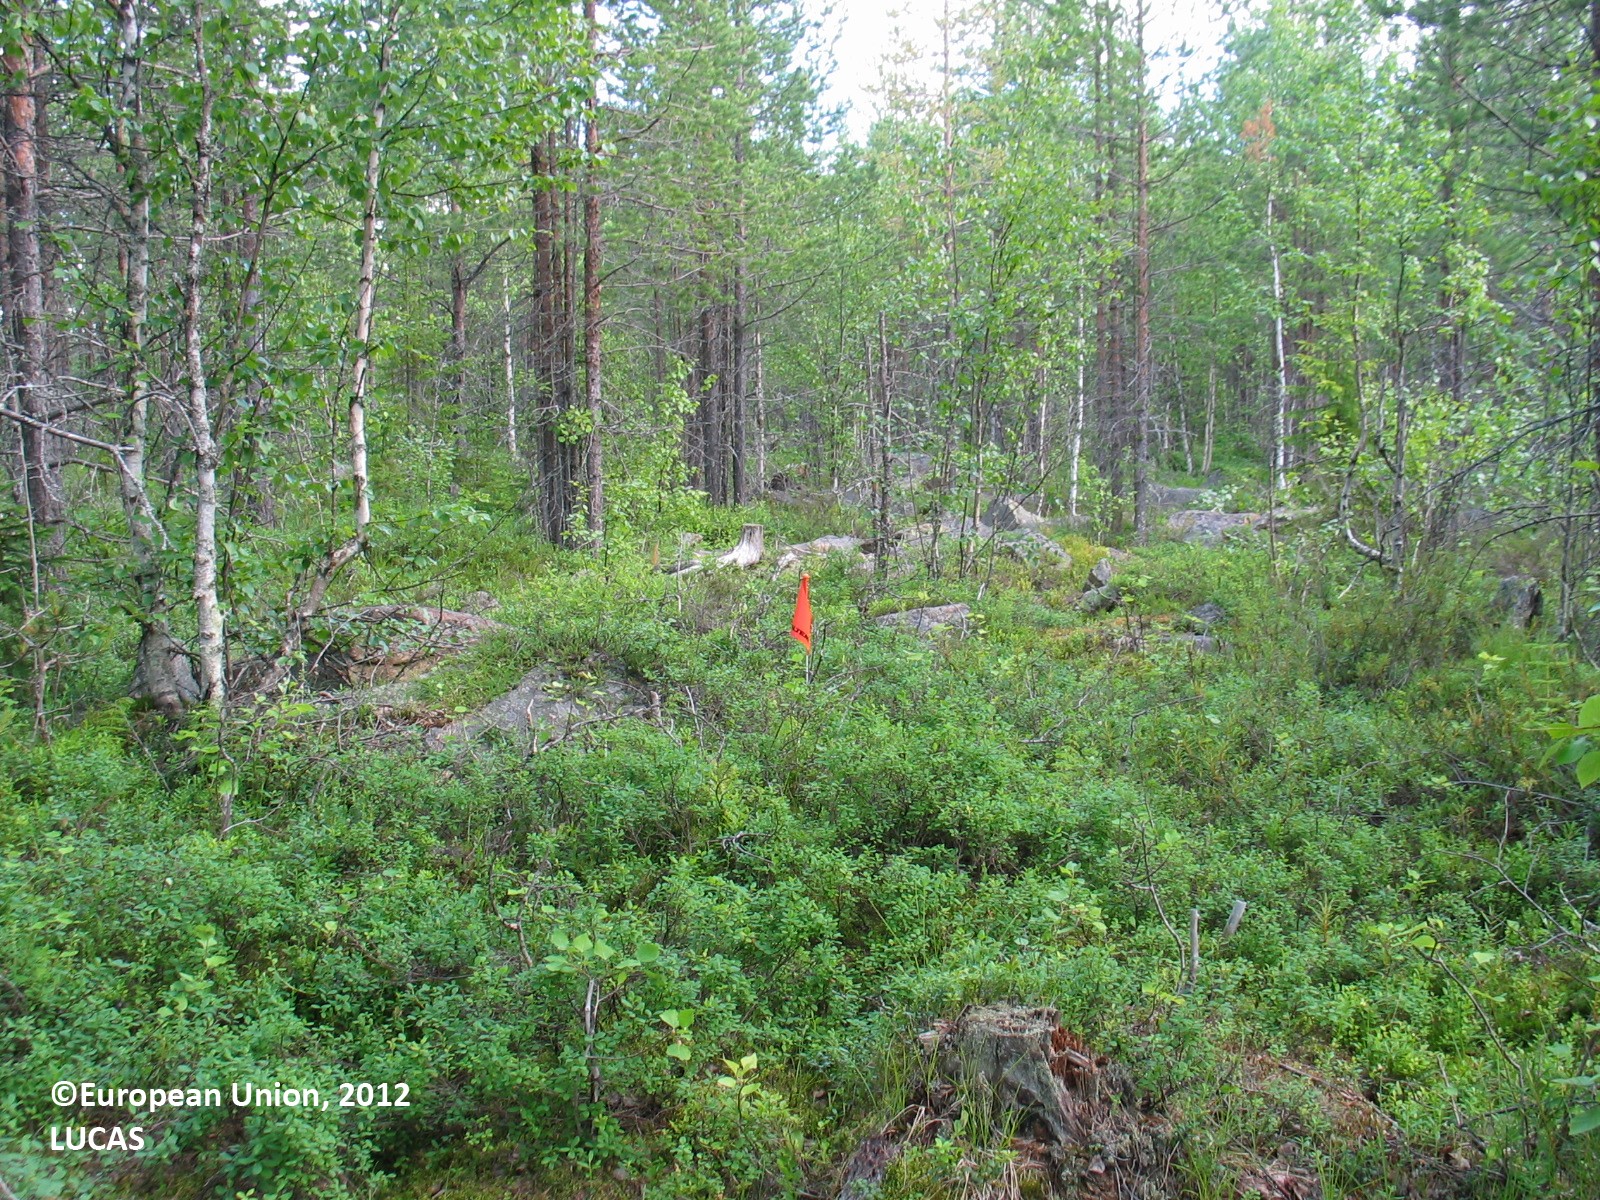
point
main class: Woodland
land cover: Pine dominated mixed woodland
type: boreal forest
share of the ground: 25 - 50 %
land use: Forestry
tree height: > 5 m
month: July
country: FI
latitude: 65.8043
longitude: 24.9975
